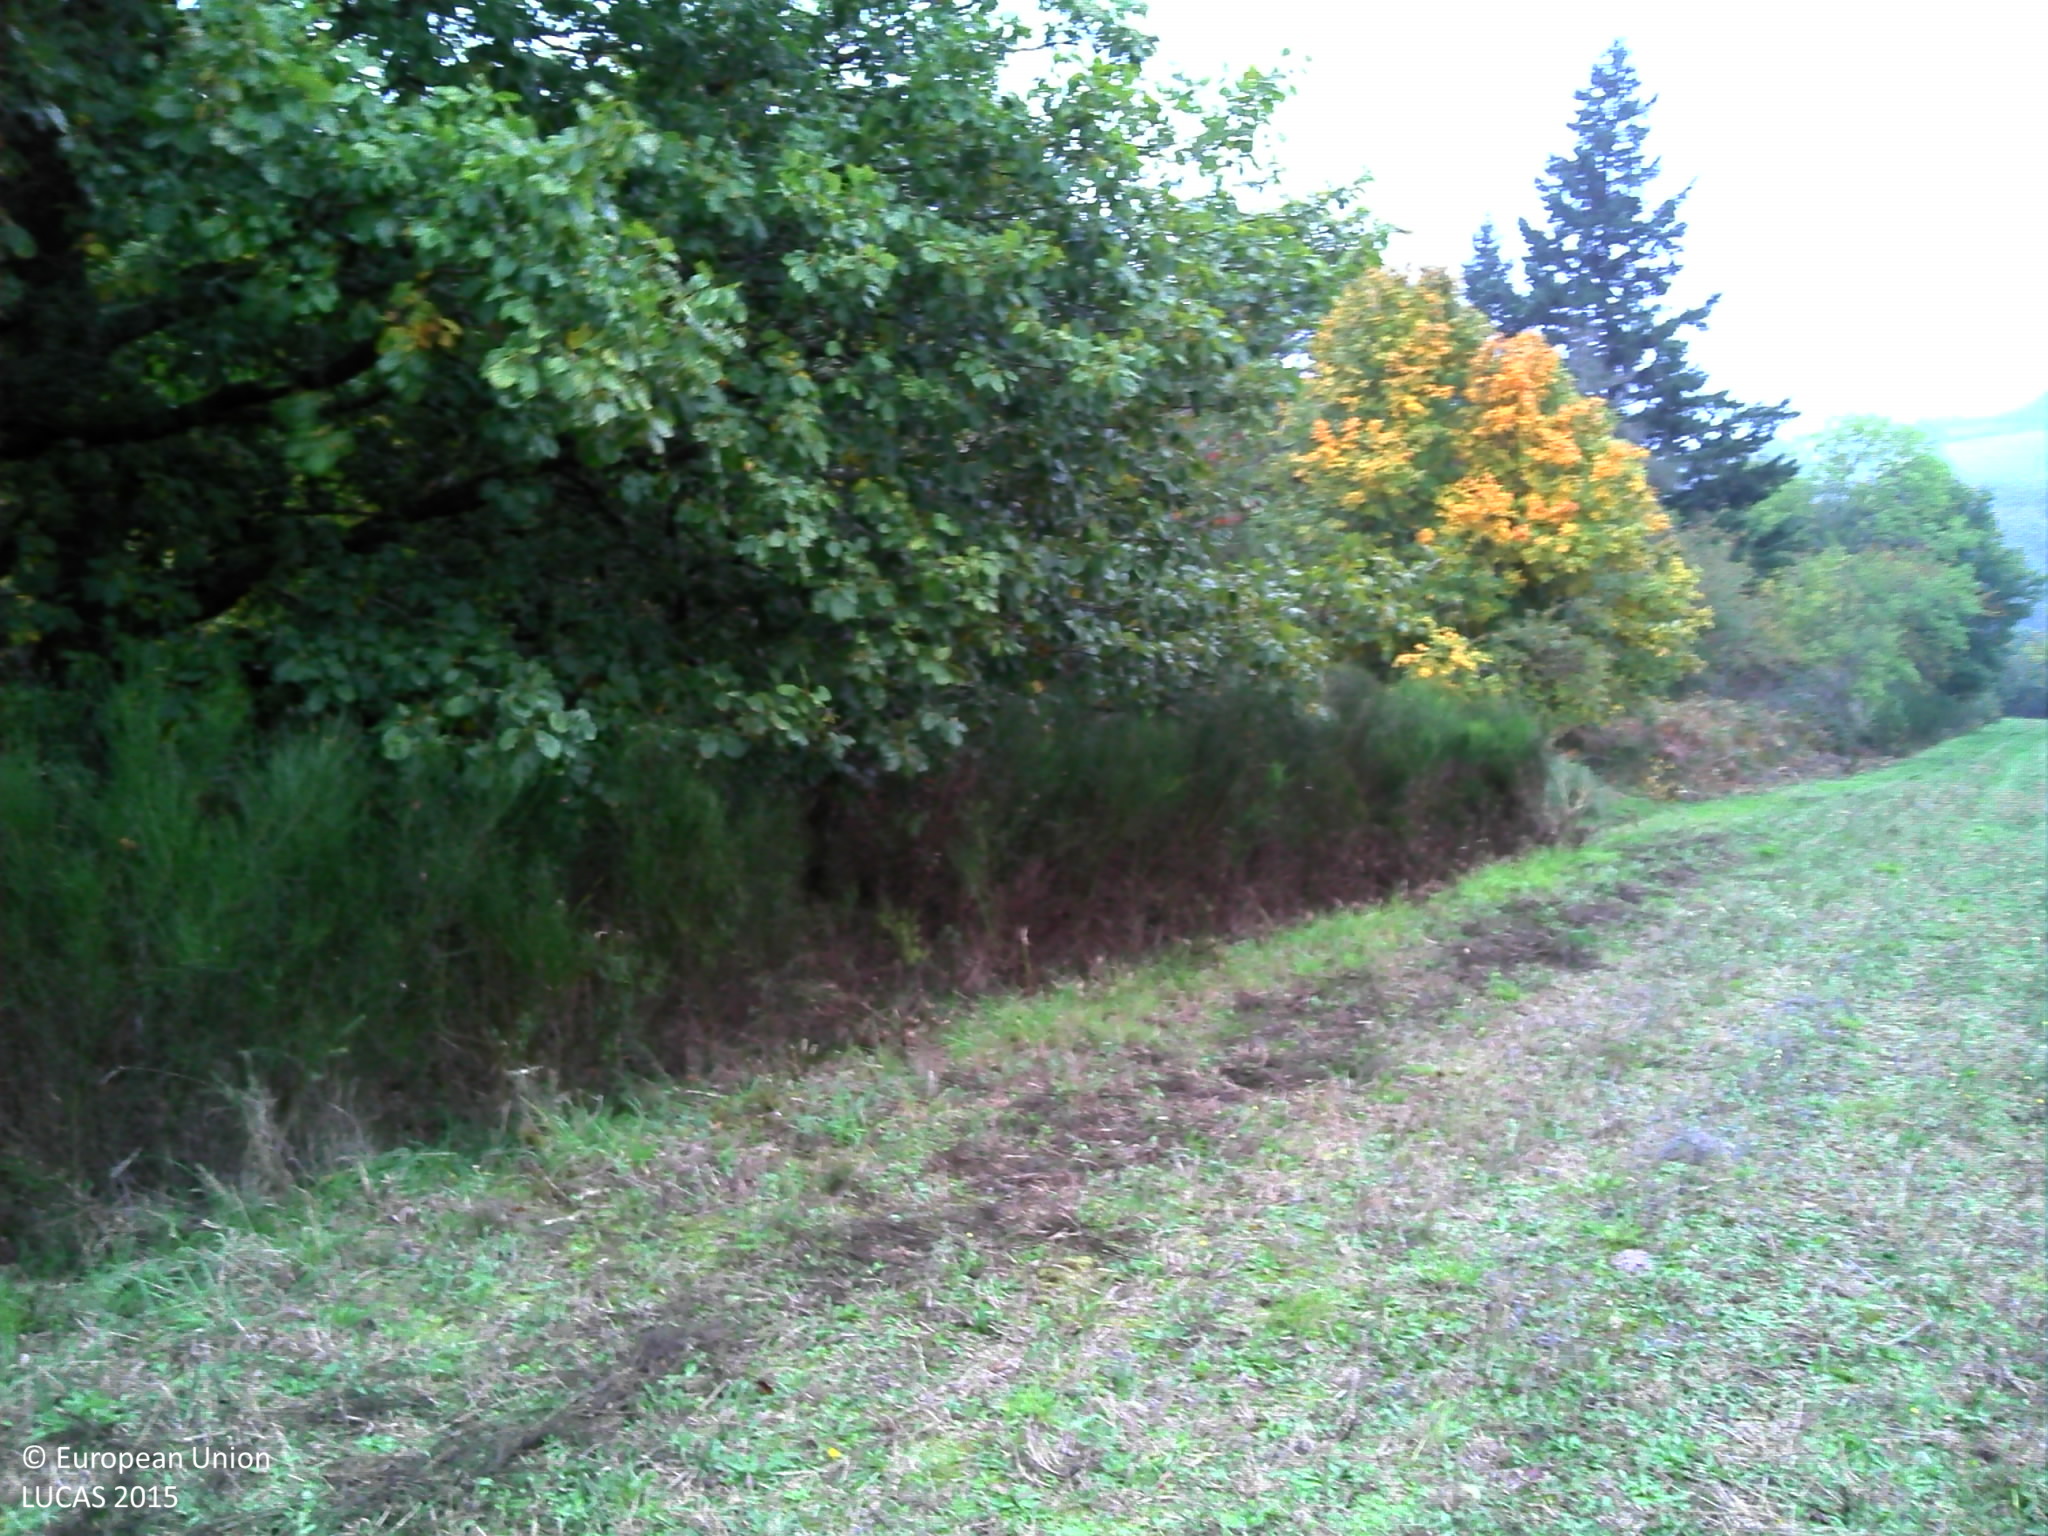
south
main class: Grassland
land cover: Grassland without tree/shrub cover
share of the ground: > 75 %
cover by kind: herbaceous plants 100 %
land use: Agriculture (excluding fallow land and kitchen gardens)
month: October
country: FR
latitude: 46.0516
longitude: 3.0324
